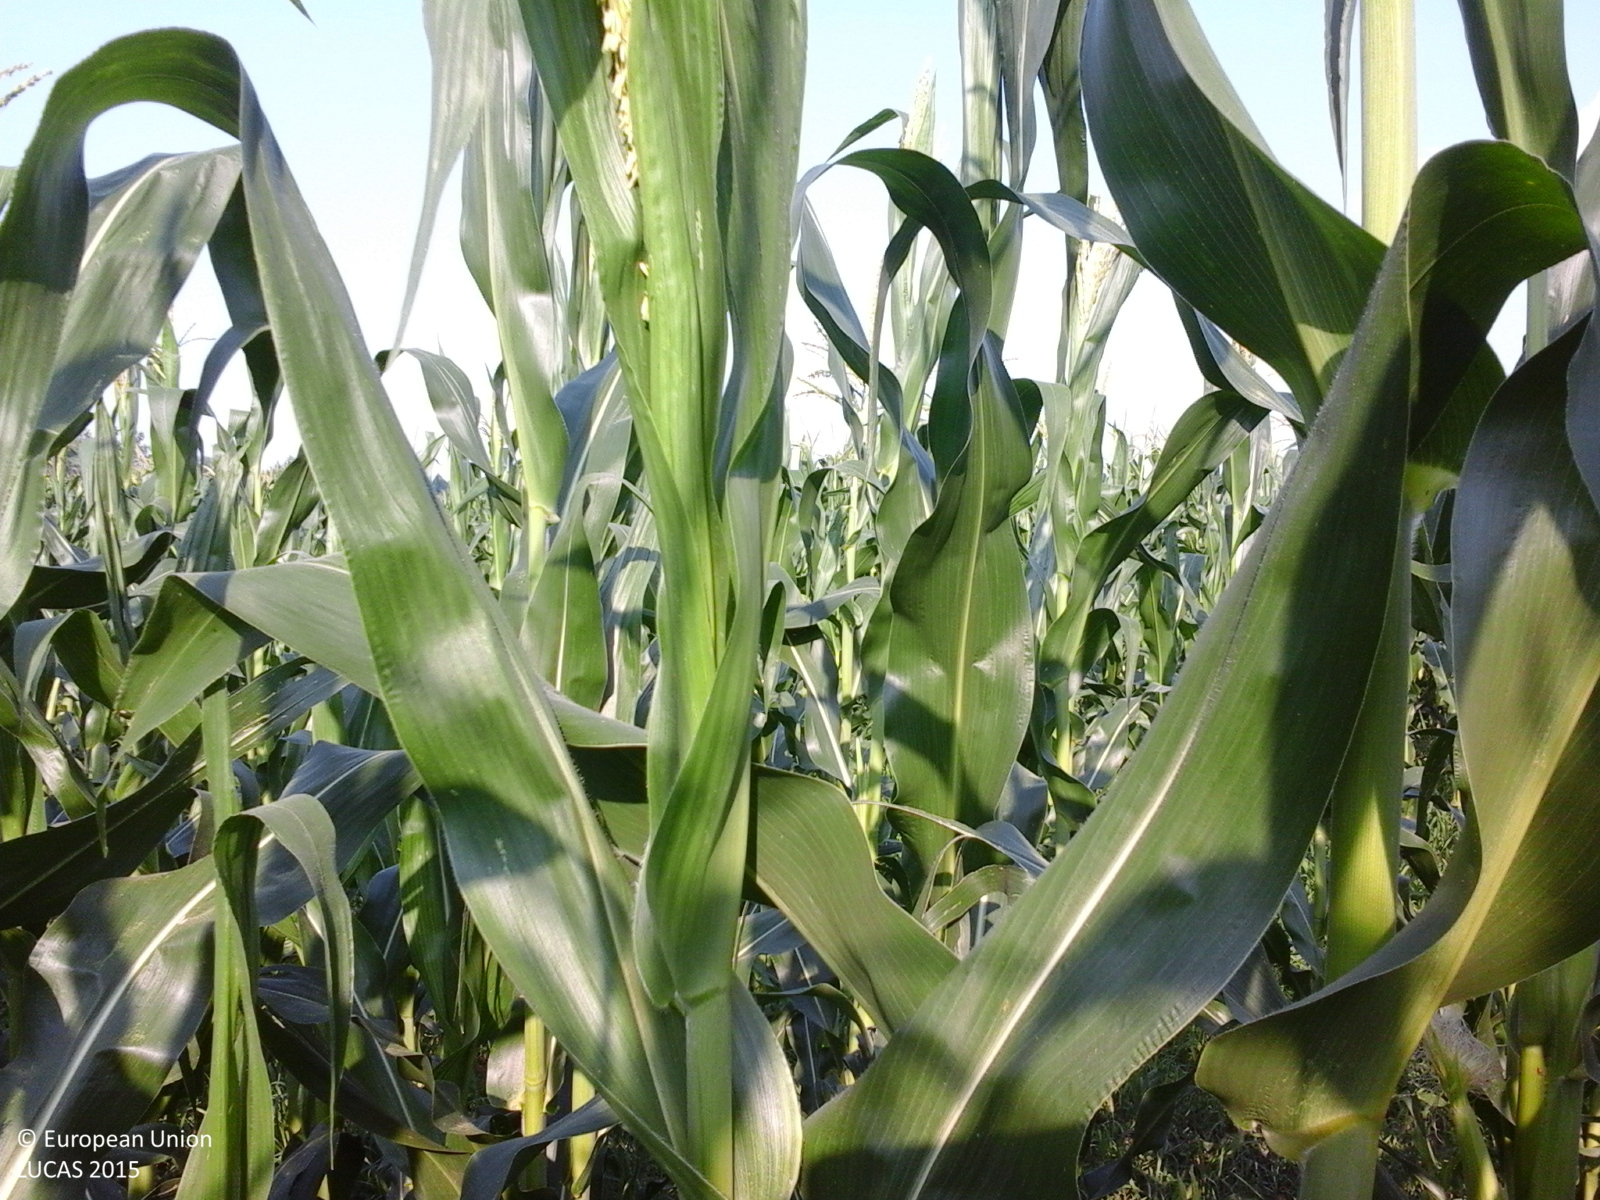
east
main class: Cropland
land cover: Maize
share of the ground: > 75 %
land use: Agriculture (excluding fallow land and kitchen gardens)
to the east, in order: Maize; Common wheat; Maize; Oats; Common wheat; Tracks; Abandoned hedges; Grassland without tree/shrub cover; Abandoned hedges; Grassland without tree/shrub cover; Inland fresh running water
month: July
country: RO
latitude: 44.8887
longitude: 25.5822
